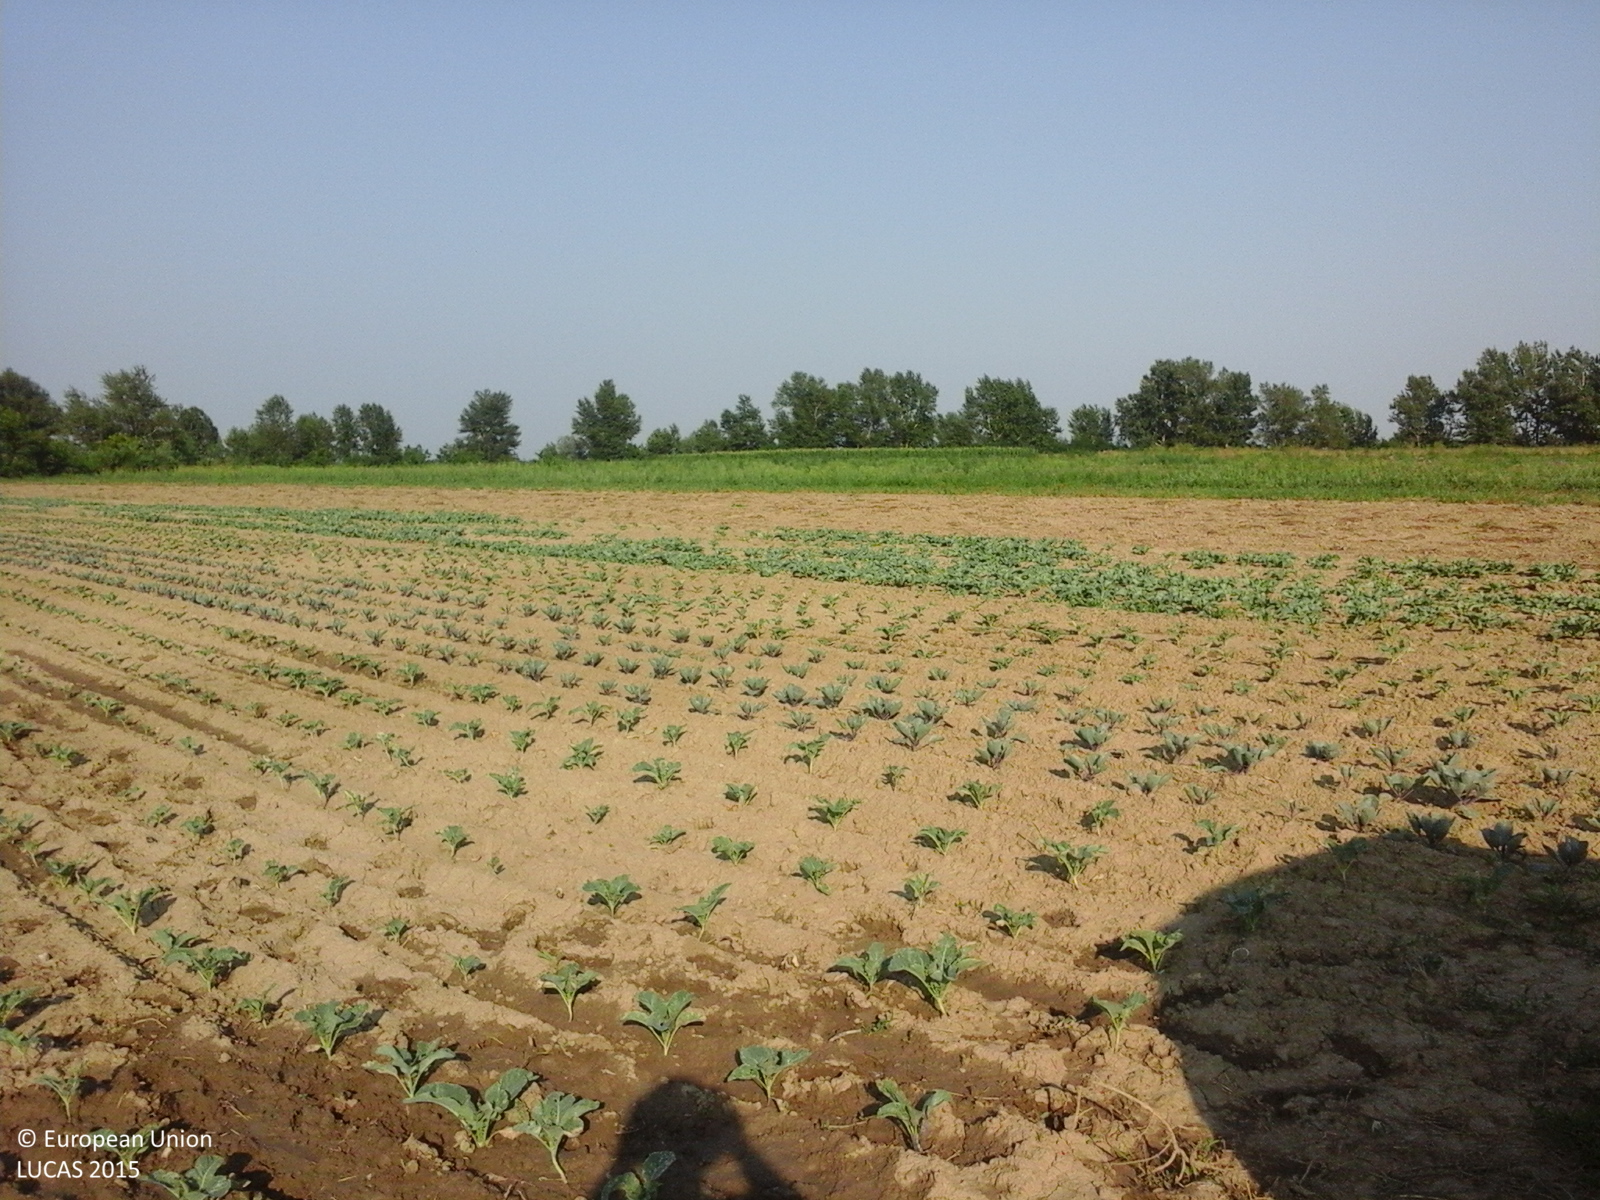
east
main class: Cropland
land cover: Potatoes
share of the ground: 50 - 75 %
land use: Agriculture (excluding fallow land and kitchen gardens)
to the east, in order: Potatoes; Tracks; Potatoes; Other fresh vegetables; Potatoes; Other fresh vegetables; Potatoes; Other fresh vegetables
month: July
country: RO
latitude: 44.6201
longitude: 25.6611
